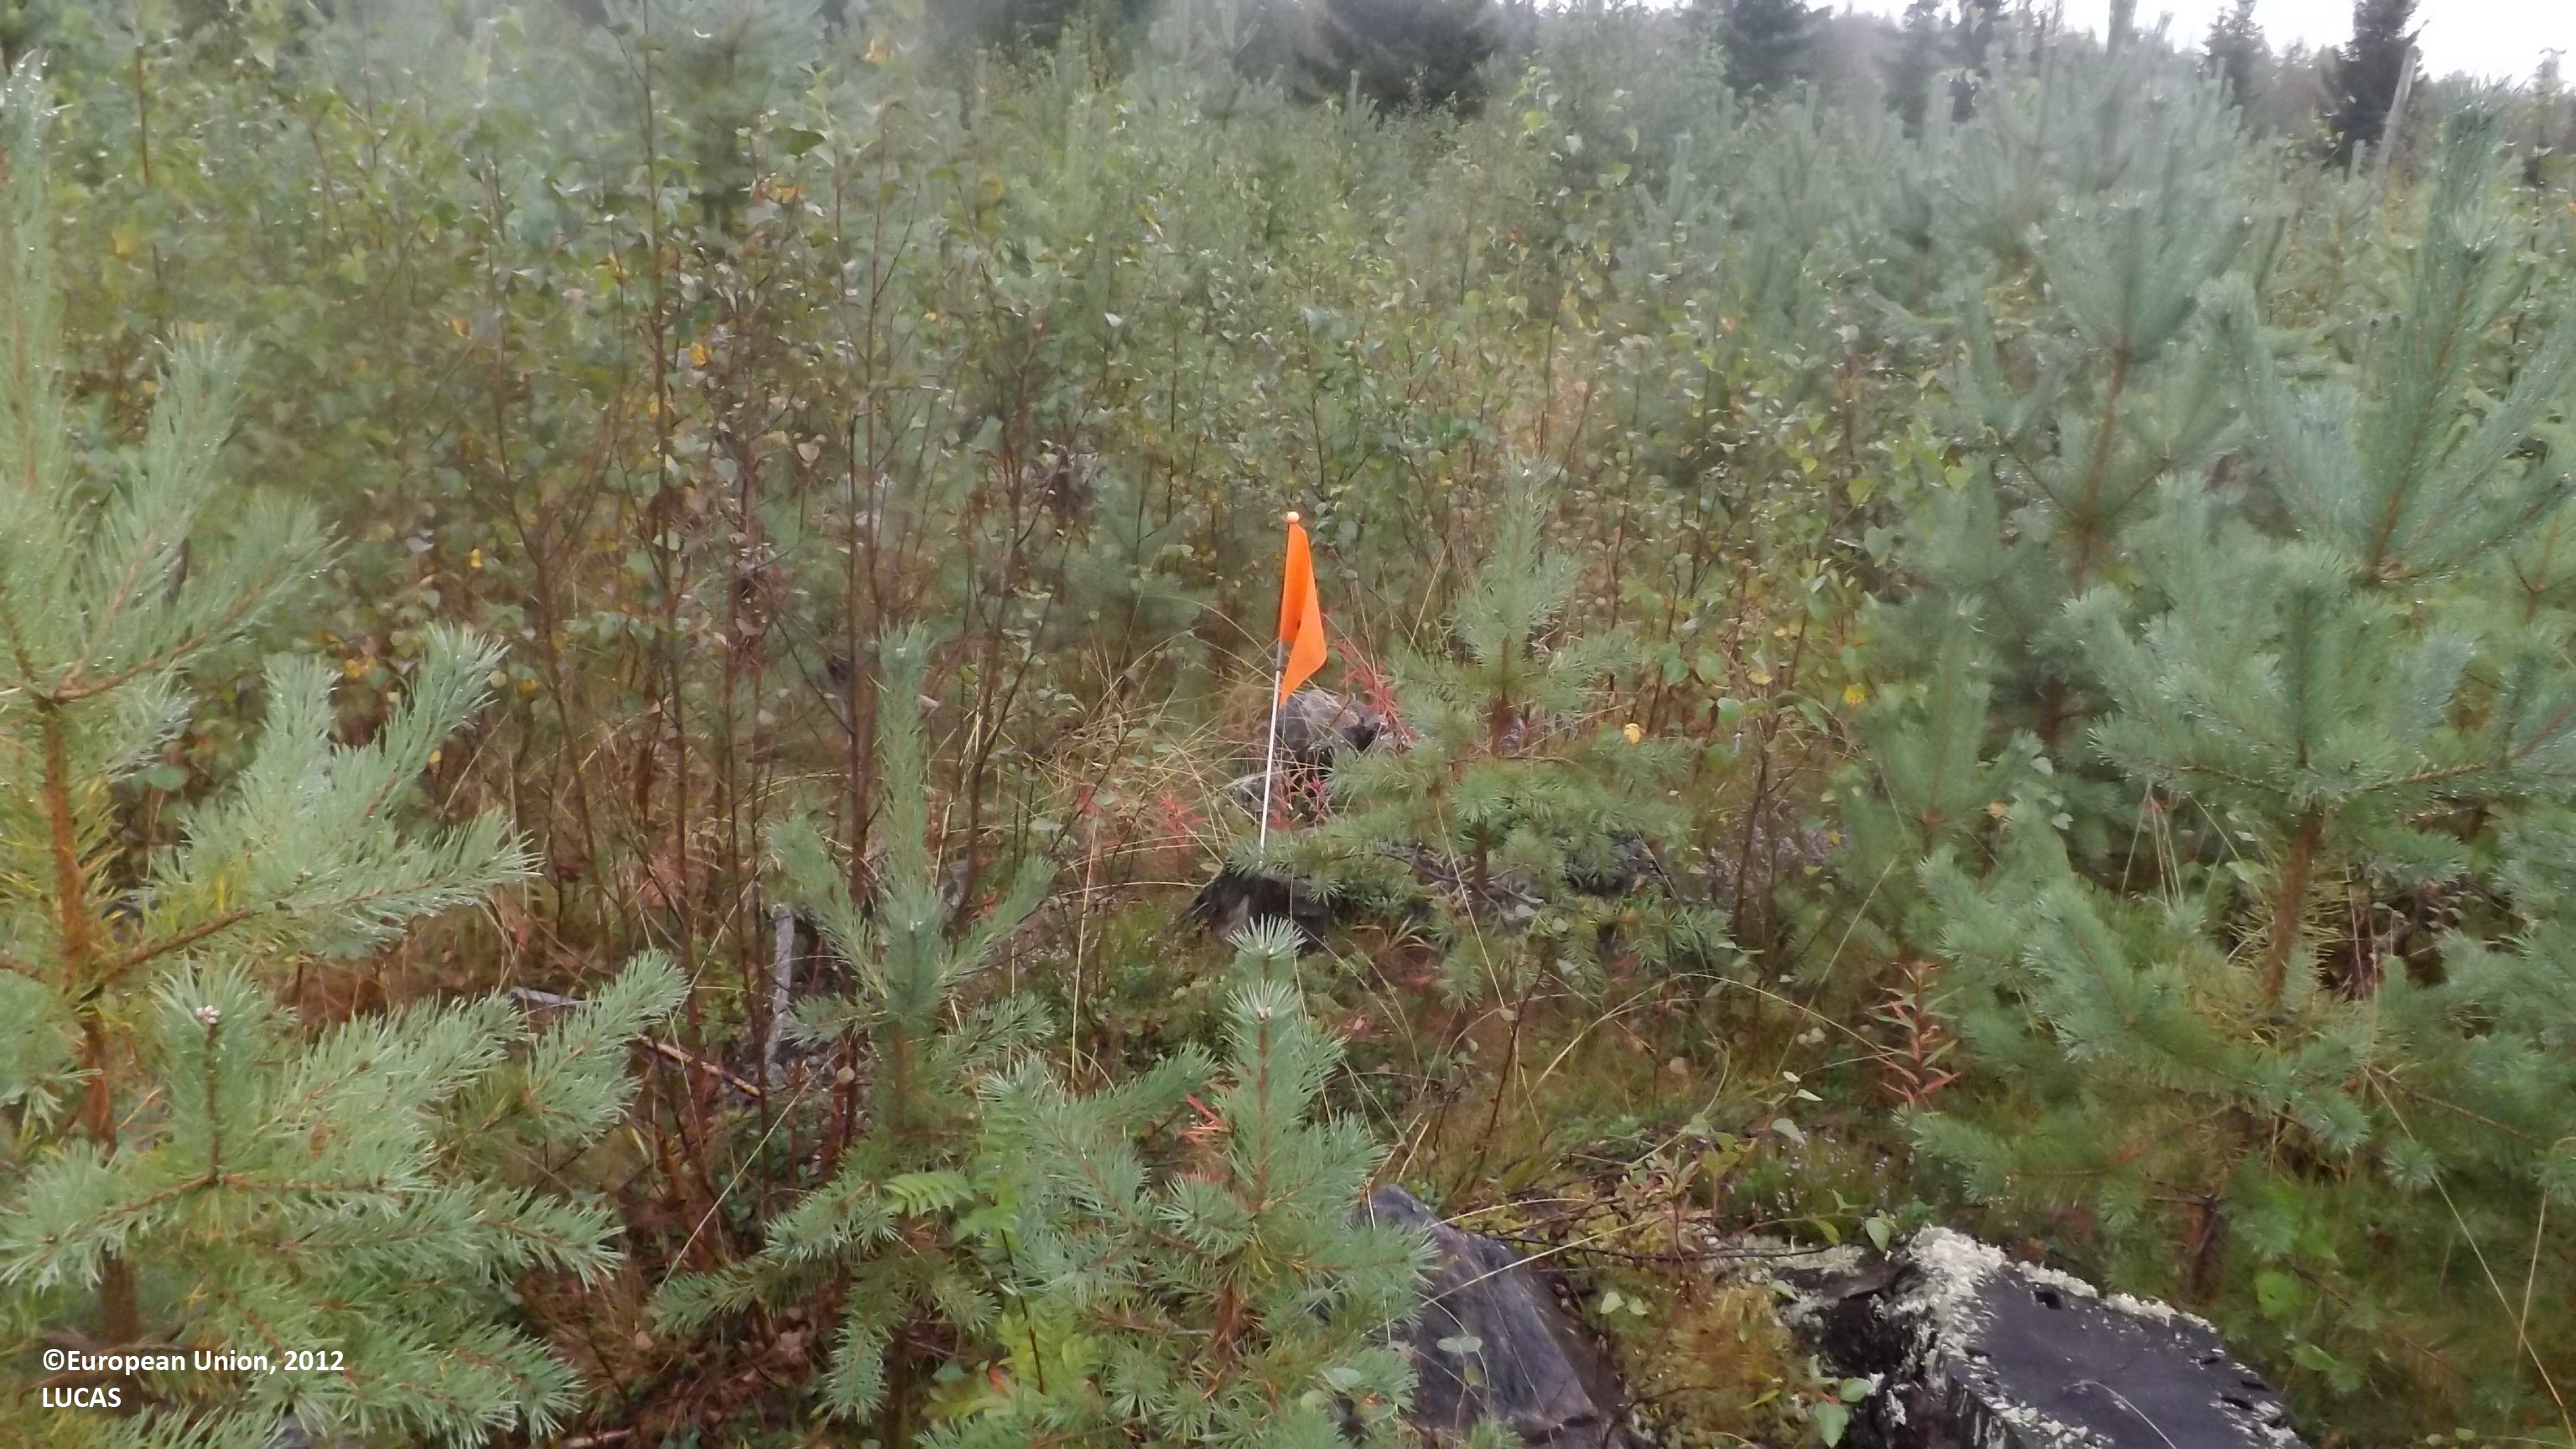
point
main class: Woodland
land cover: Pine dominated mixed woodland
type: boreal forest
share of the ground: 25 - 50 %
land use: Forestry
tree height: < 5 m
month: August
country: FI
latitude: 63.7700
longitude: 23.6283
